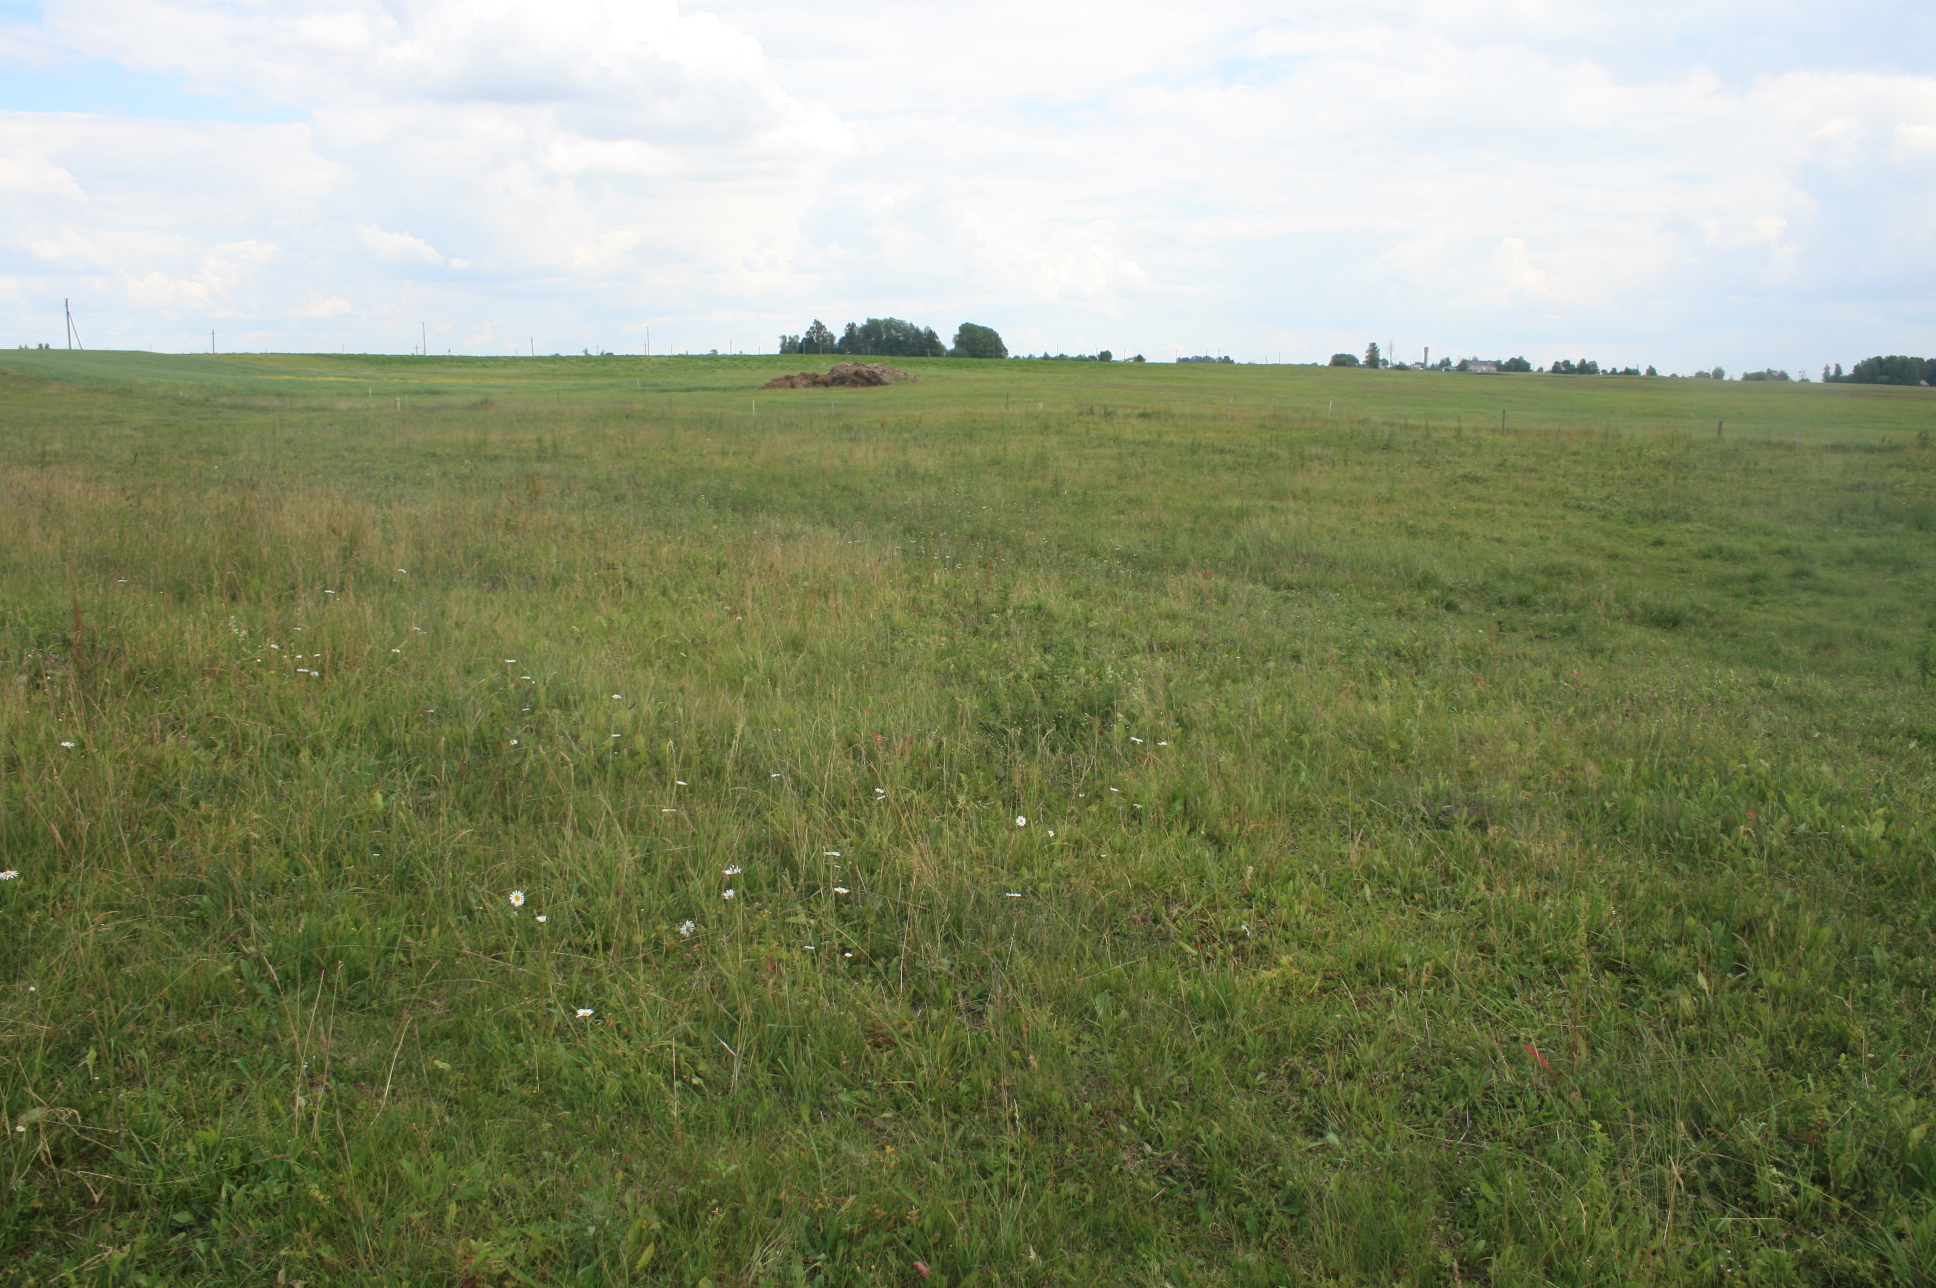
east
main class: Grassland
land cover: Grassland without tree/shrub cover
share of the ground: > 75 %
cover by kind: herbaceous plants 100 %
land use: Agriculture (excluding fallow land and kitchen gardens)
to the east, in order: Grassland without tree/shrub cover; Fences; Grassland without tree/shrub cover
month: June
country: LT
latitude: 55.2586
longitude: 21.9962
